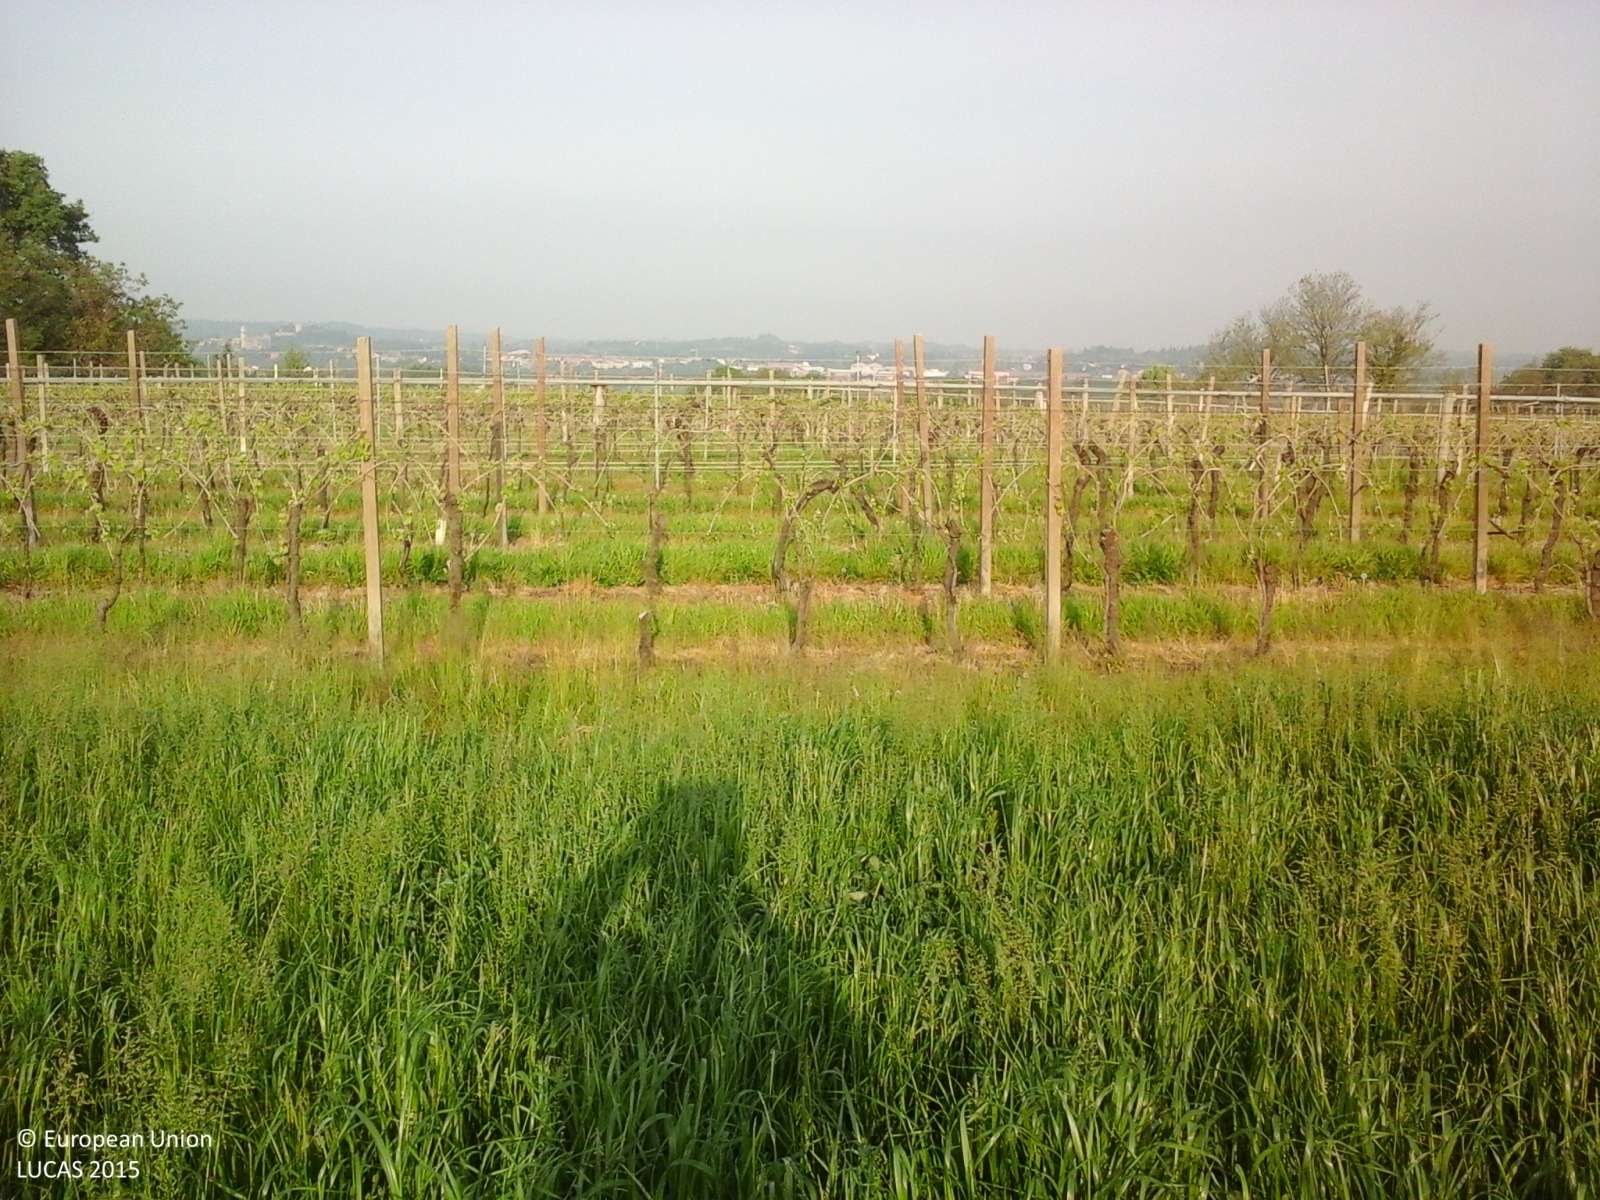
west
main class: Cropland
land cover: Other leguminous and mixtures for fodder
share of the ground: > 75 %
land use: Agriculture (excluding fallow land and kitchen gardens)
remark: Tilled/Sowed
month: April
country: IT
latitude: 45.3938
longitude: 10.7268
